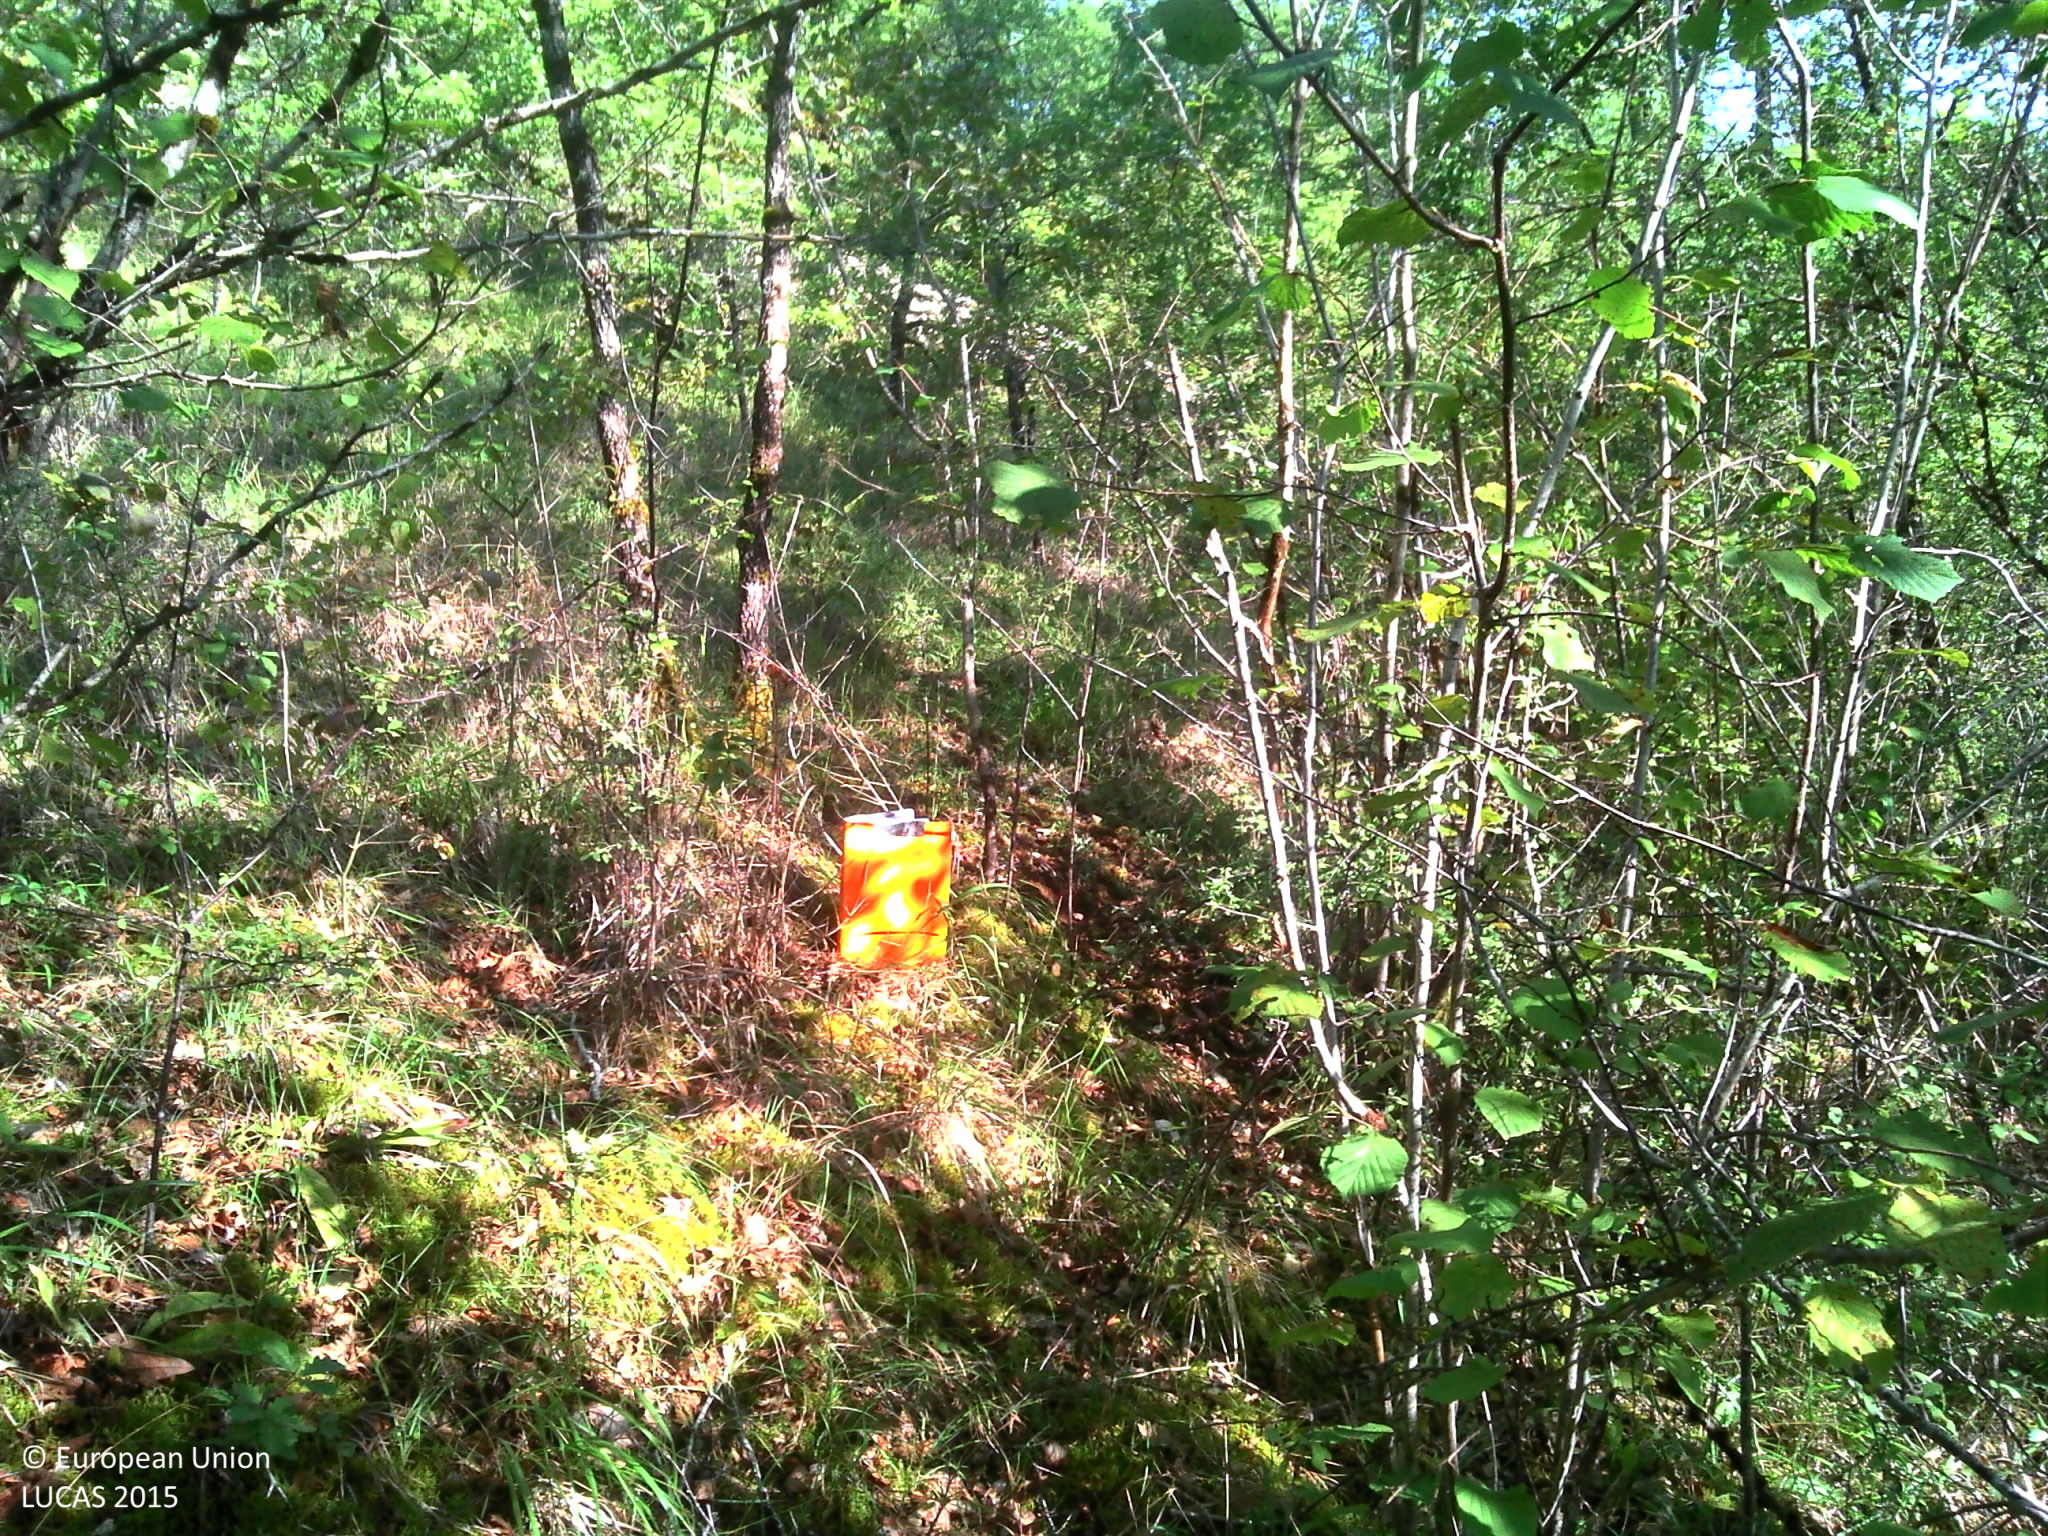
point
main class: Woodland
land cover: Broadleaved woodland
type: thermophilous deciduous forest
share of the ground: > 75 %
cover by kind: broadleaved forest trees 60 %, shrubs 20 %, herbaceous plants 20 %
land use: Forestry
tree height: > 5 m
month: September
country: FR
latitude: 44.6697
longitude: 1.2548
